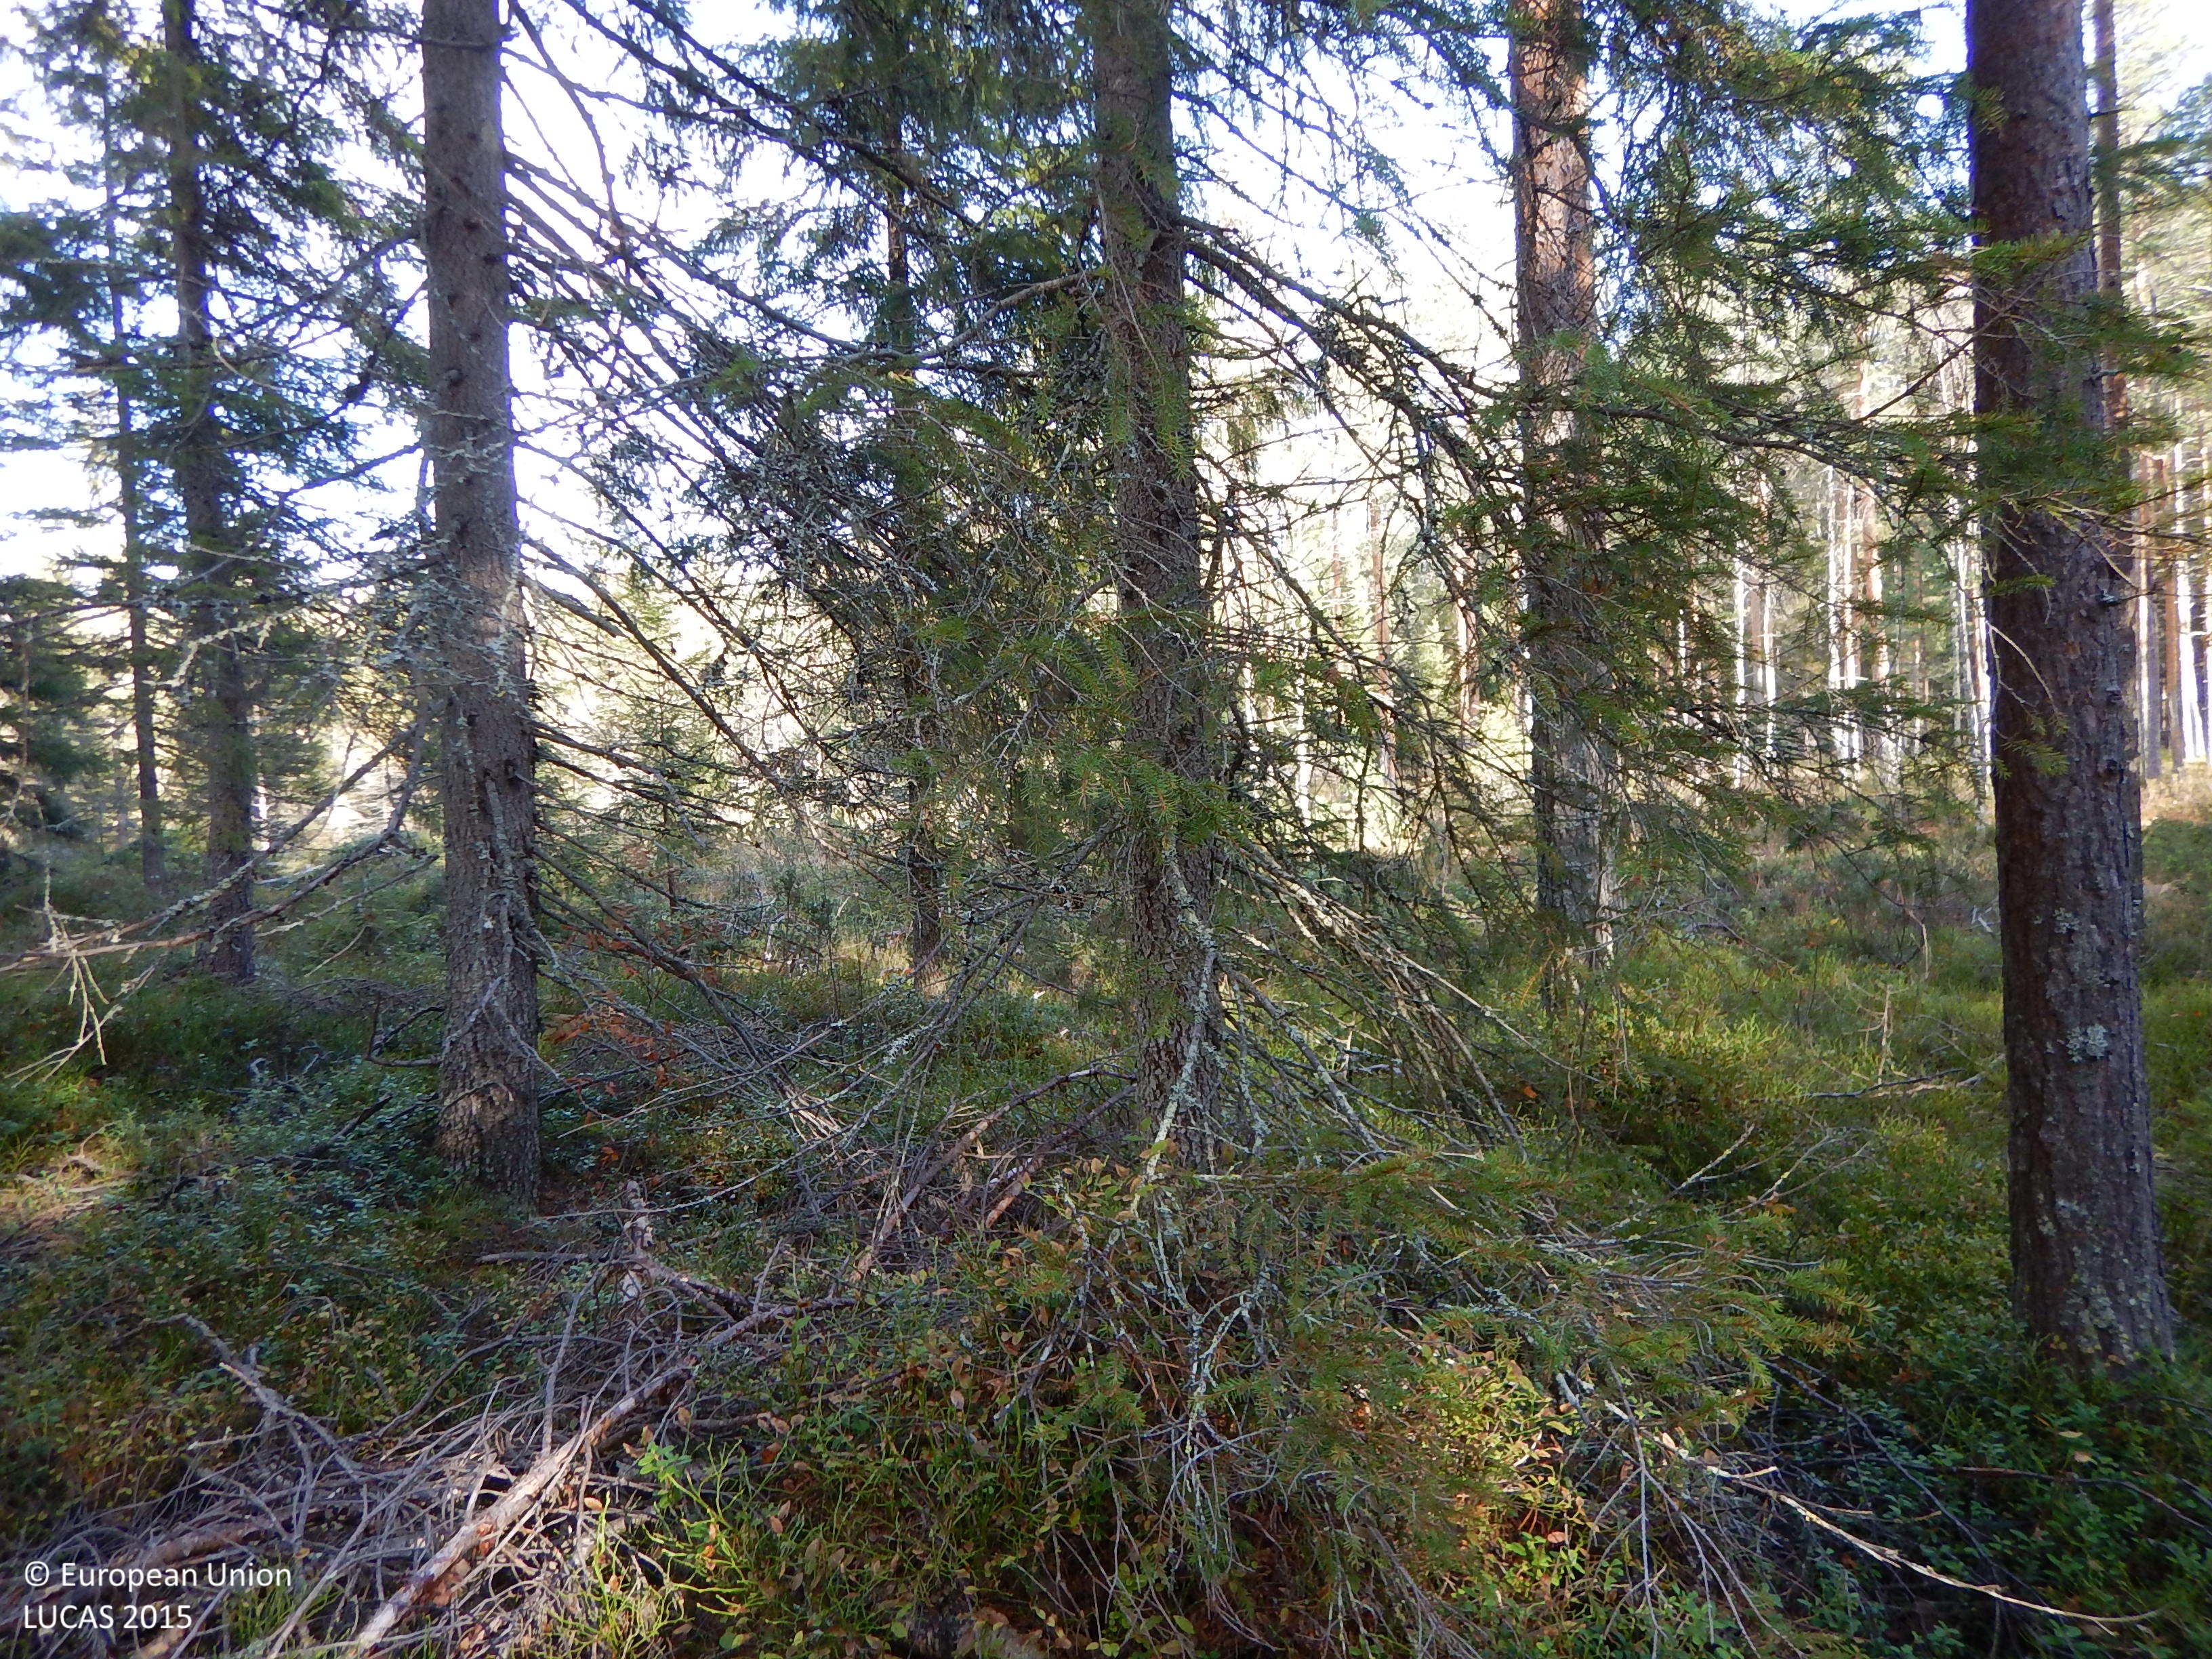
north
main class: Woodland
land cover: Other coniferous woodland
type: boreal forest
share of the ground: 50 - 75 %
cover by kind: coniferous forest trees 70 %, shrubs 15 %, lichens and mosses 10 %, herbaceous plants 5 %
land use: Forestry
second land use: Amenities, museums, leisure
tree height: > 5 m
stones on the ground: < 10 %
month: October
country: SE
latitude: 64.9672
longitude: 20.9686
